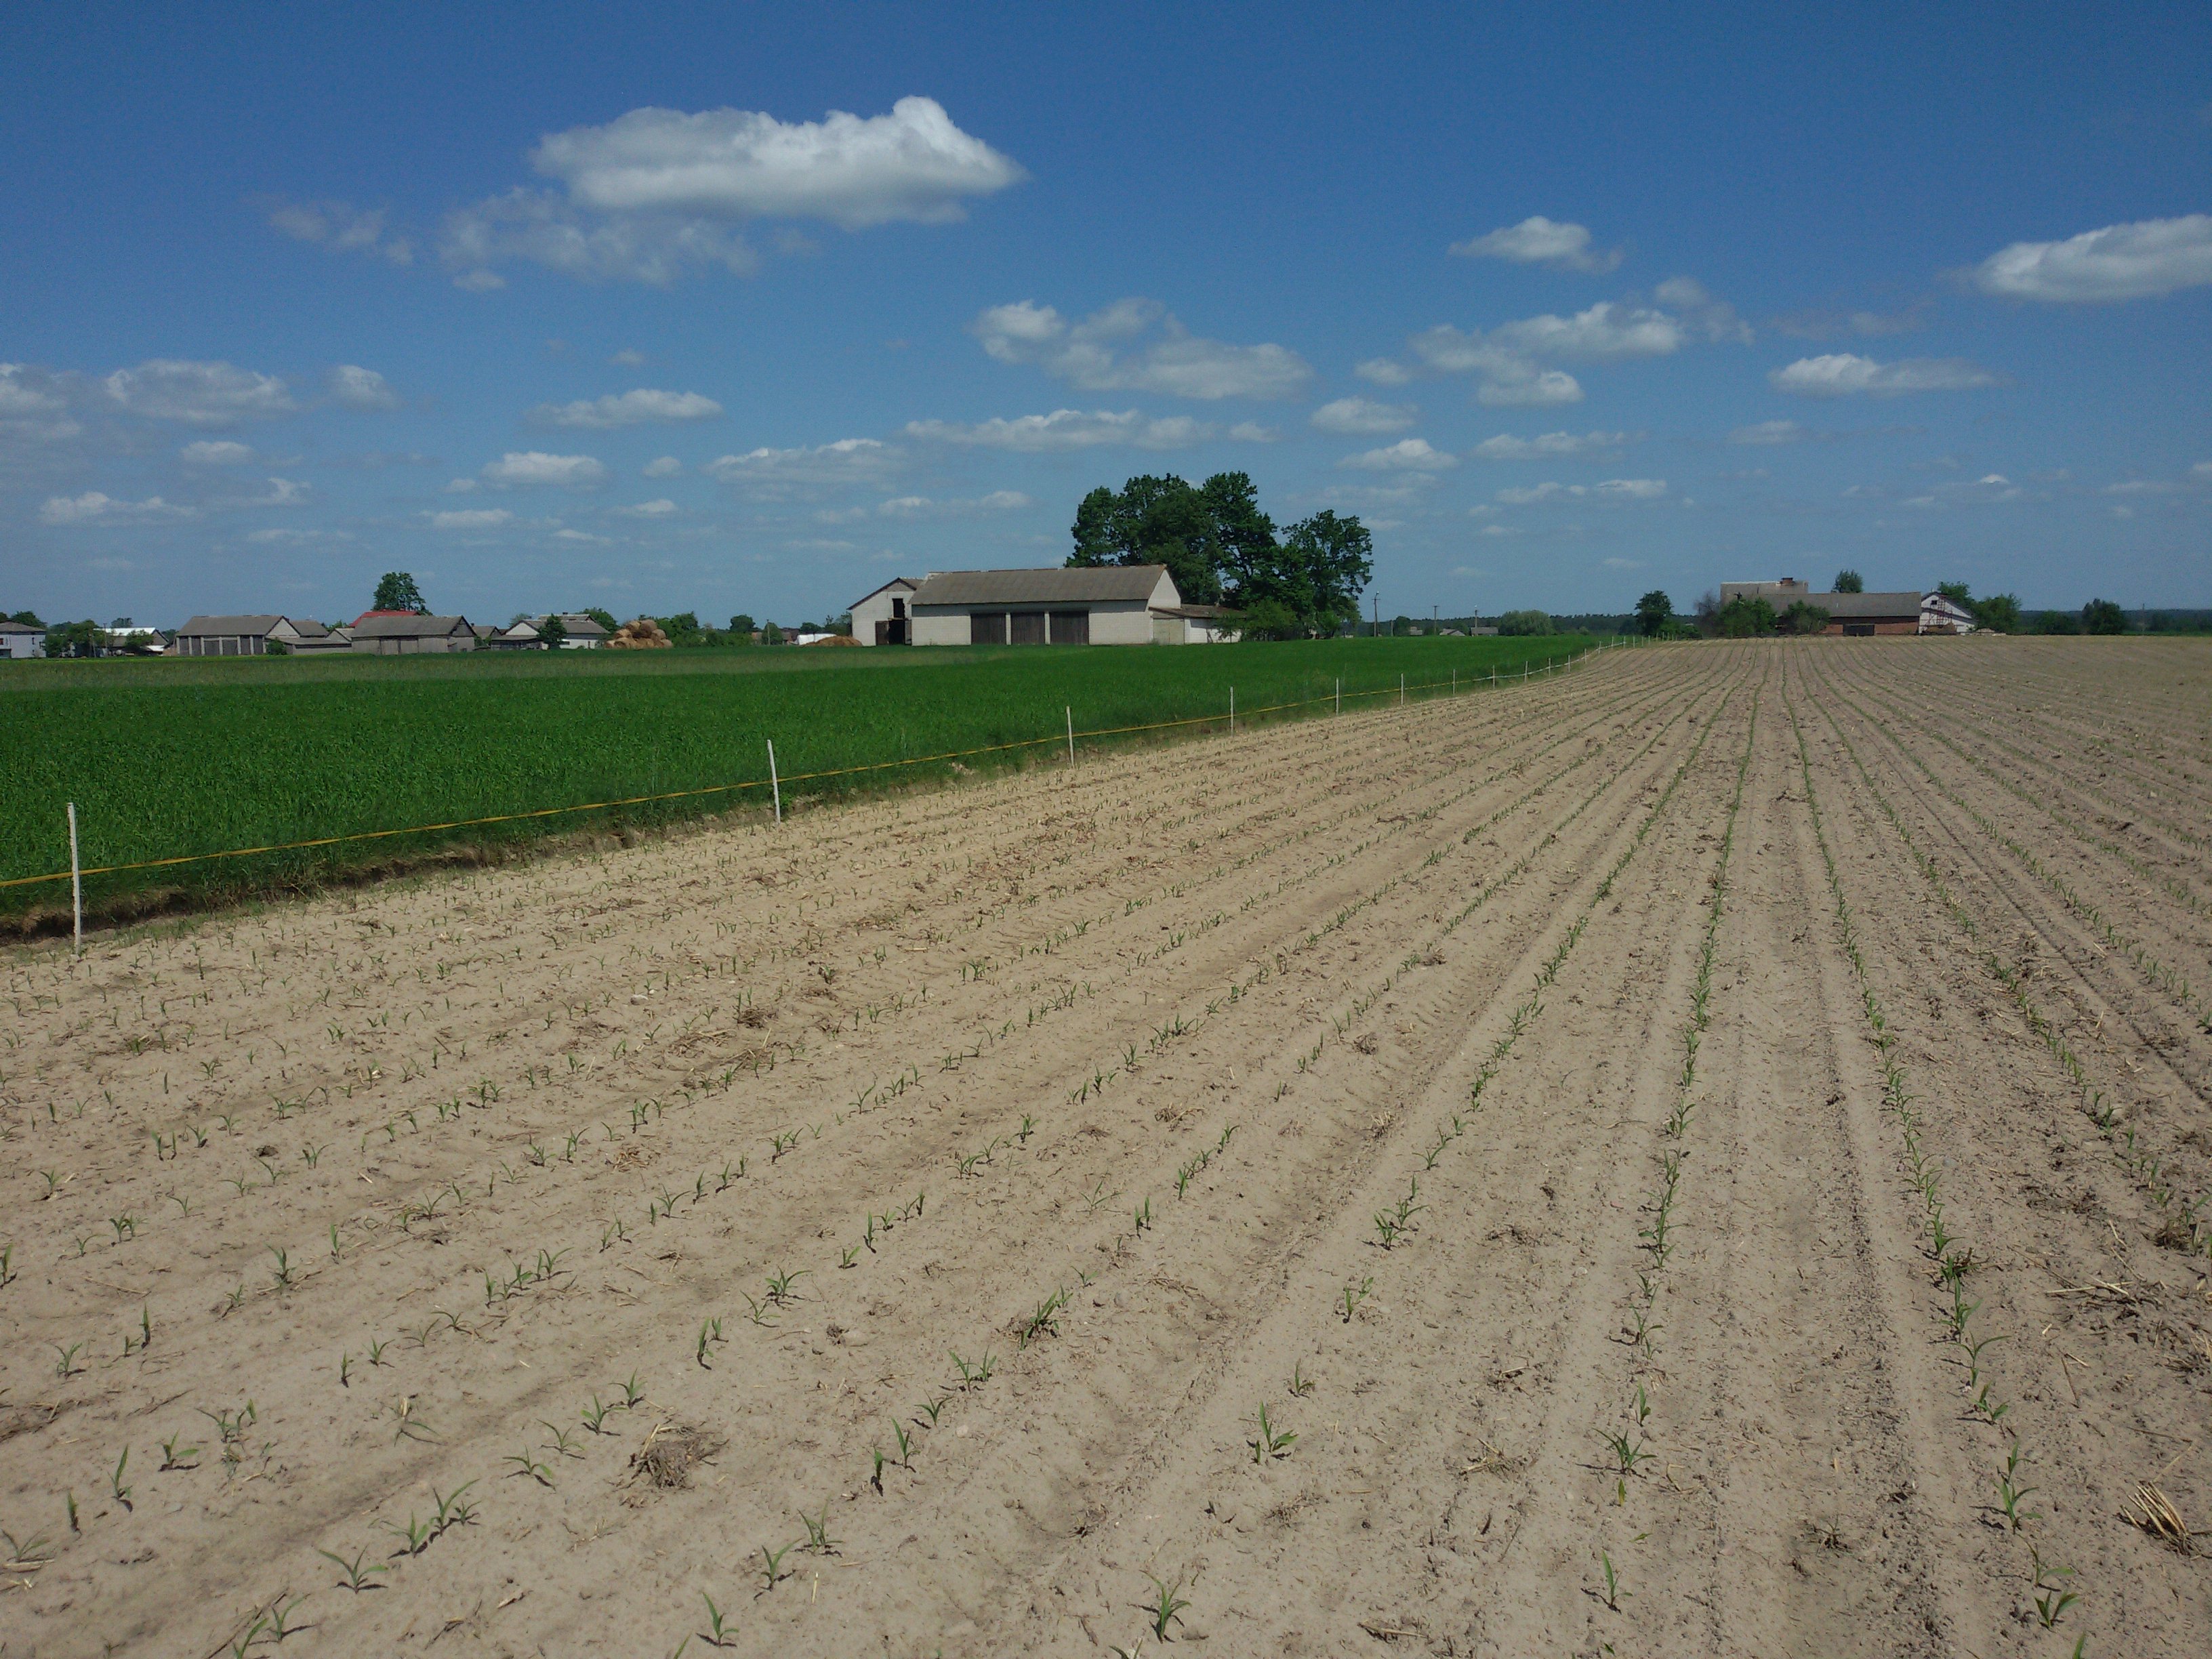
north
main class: Cropland
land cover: Maize
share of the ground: 10 - 25 %
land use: Agriculture (excluding fallow land and kitchen gardens)
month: April
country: PL
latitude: 51.2328
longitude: 21.5231
